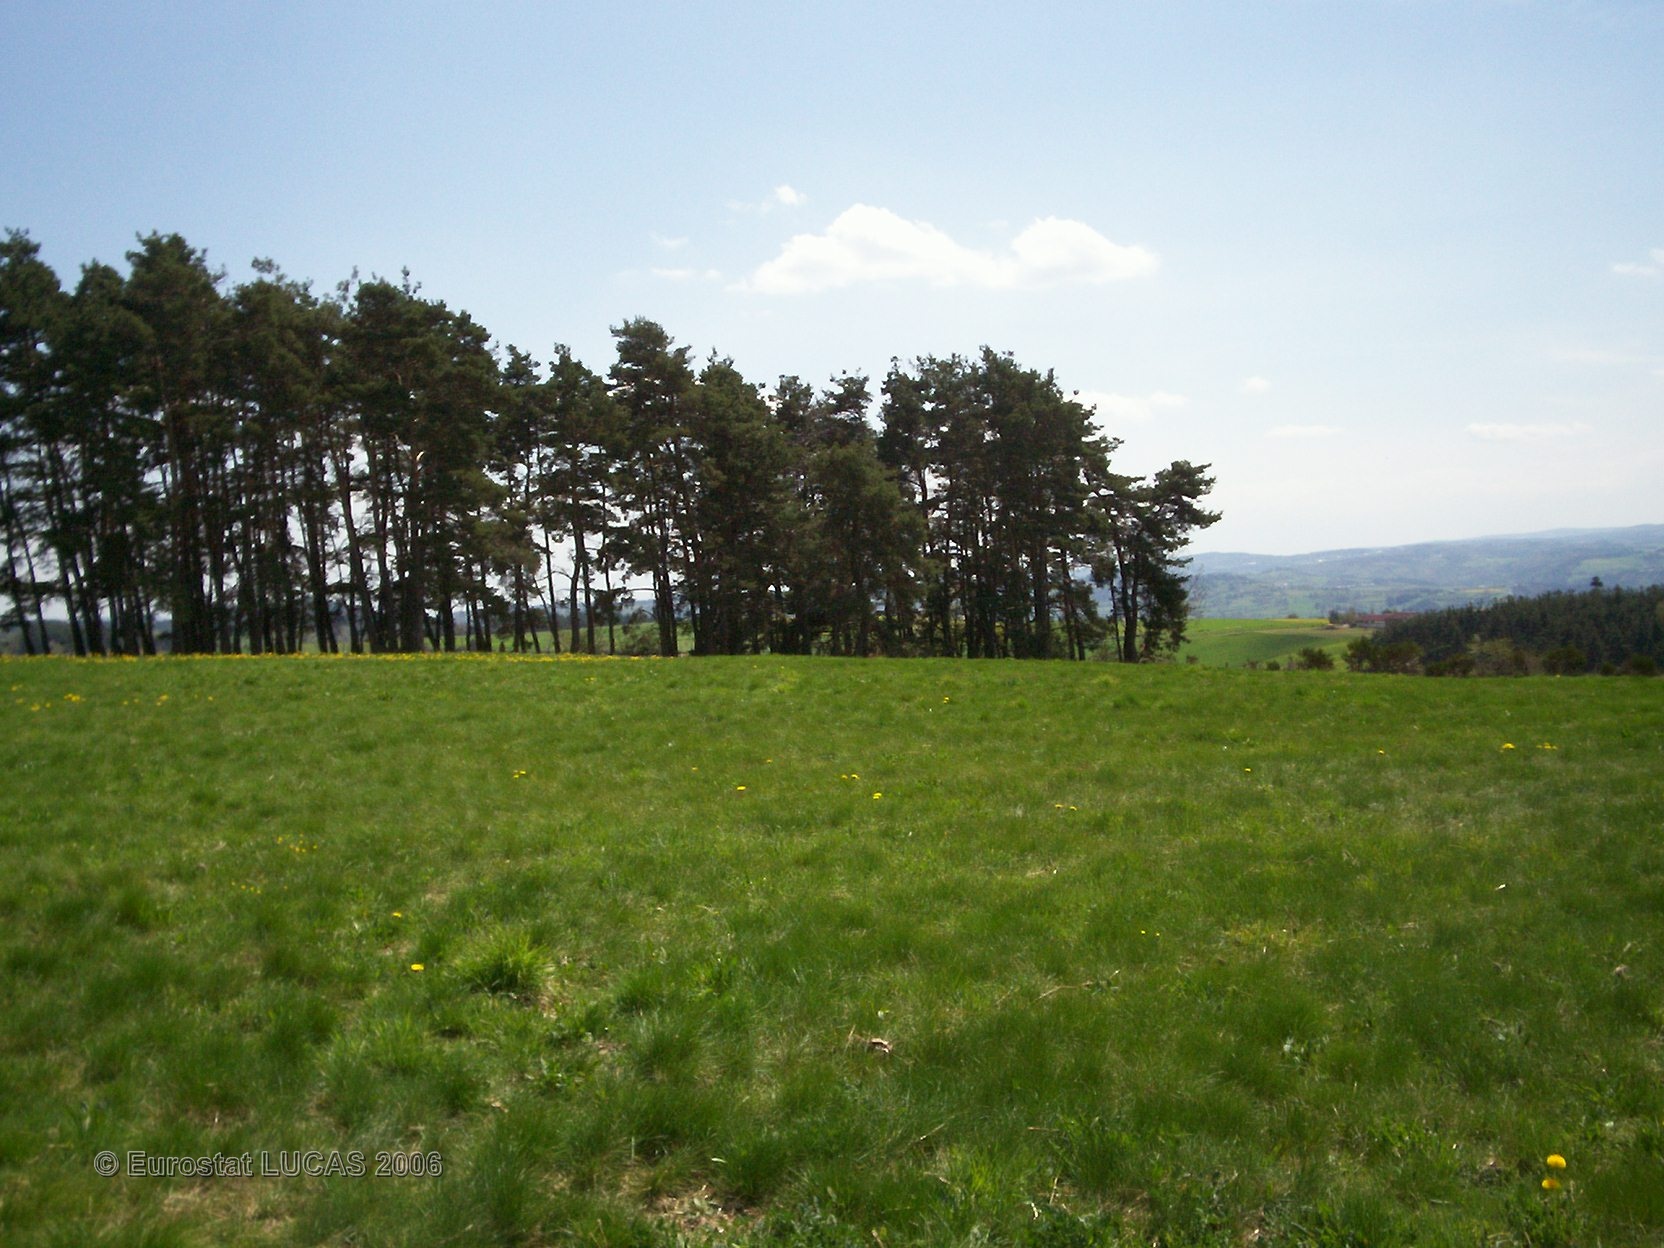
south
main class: Grassland
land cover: Grassland without tree/shrub cover
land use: Agriculture (excluding fallow land and kitchen gardens)
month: May
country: FR
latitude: 44.9821
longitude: 3.2689
